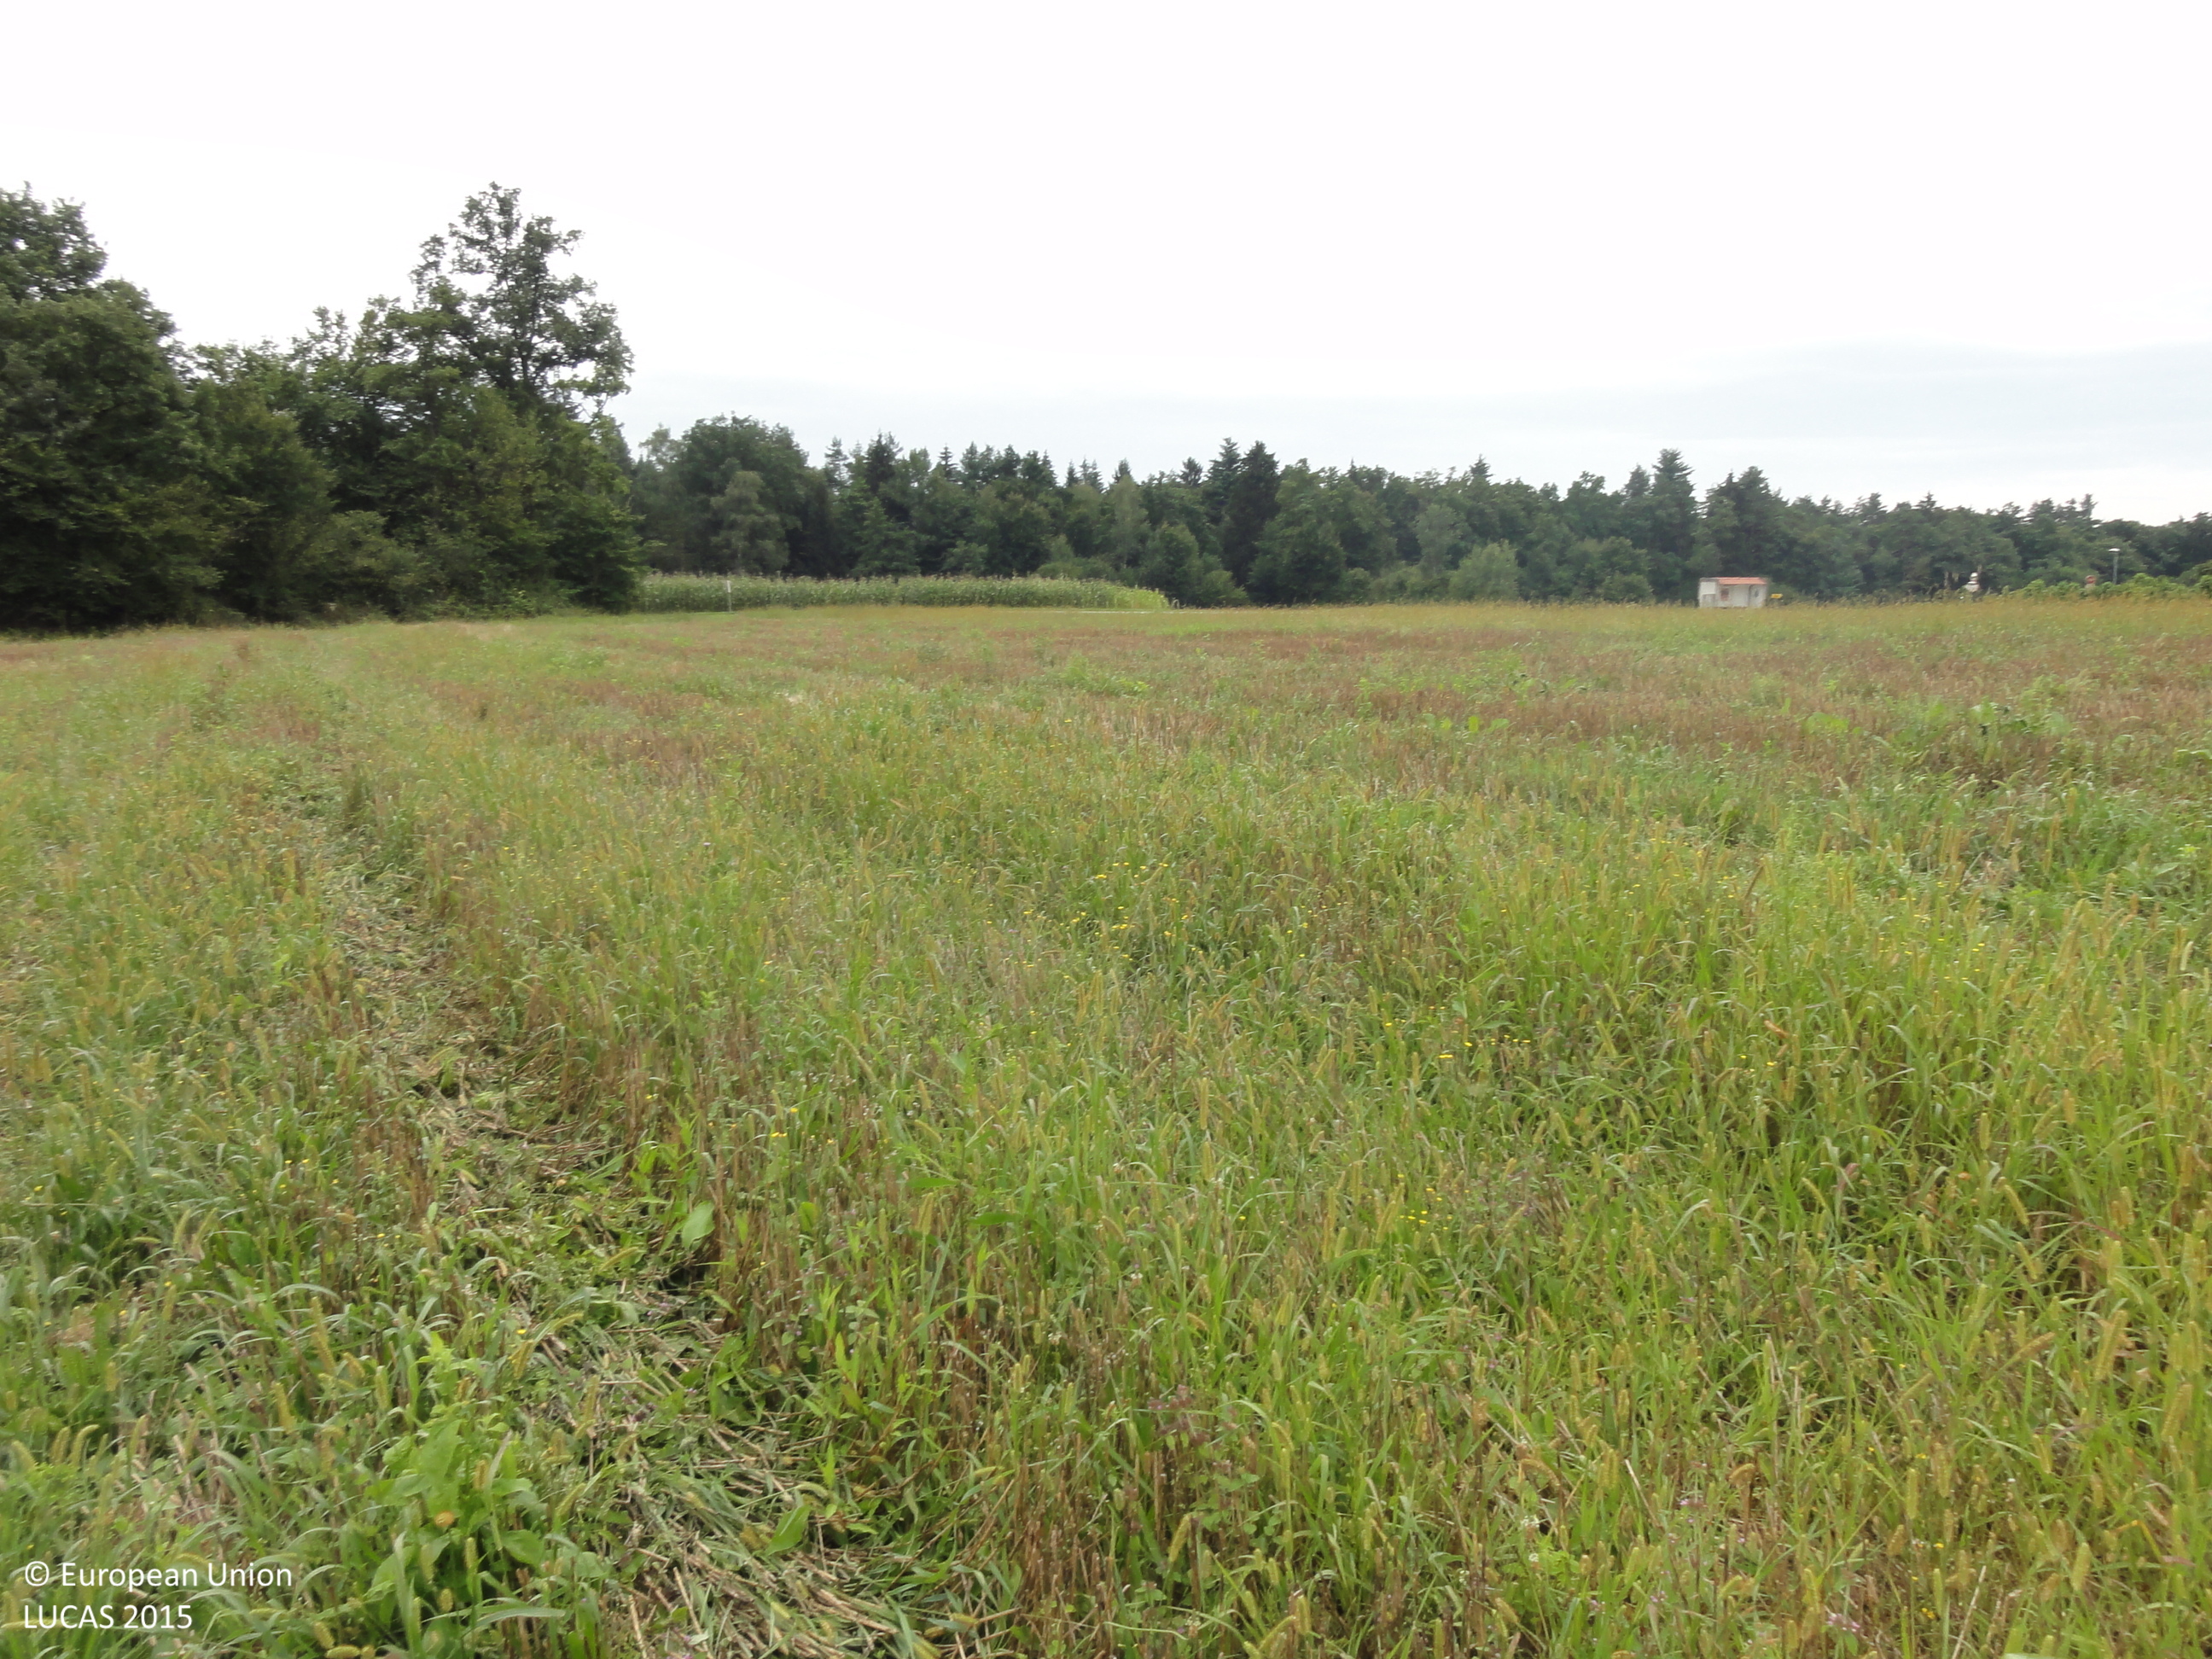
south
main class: Cropland
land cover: Common wheat
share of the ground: < 10 %
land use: Agriculture (excluding fallow land and kitchen gardens)
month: August
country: SI
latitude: 45.9413
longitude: 15.4535
